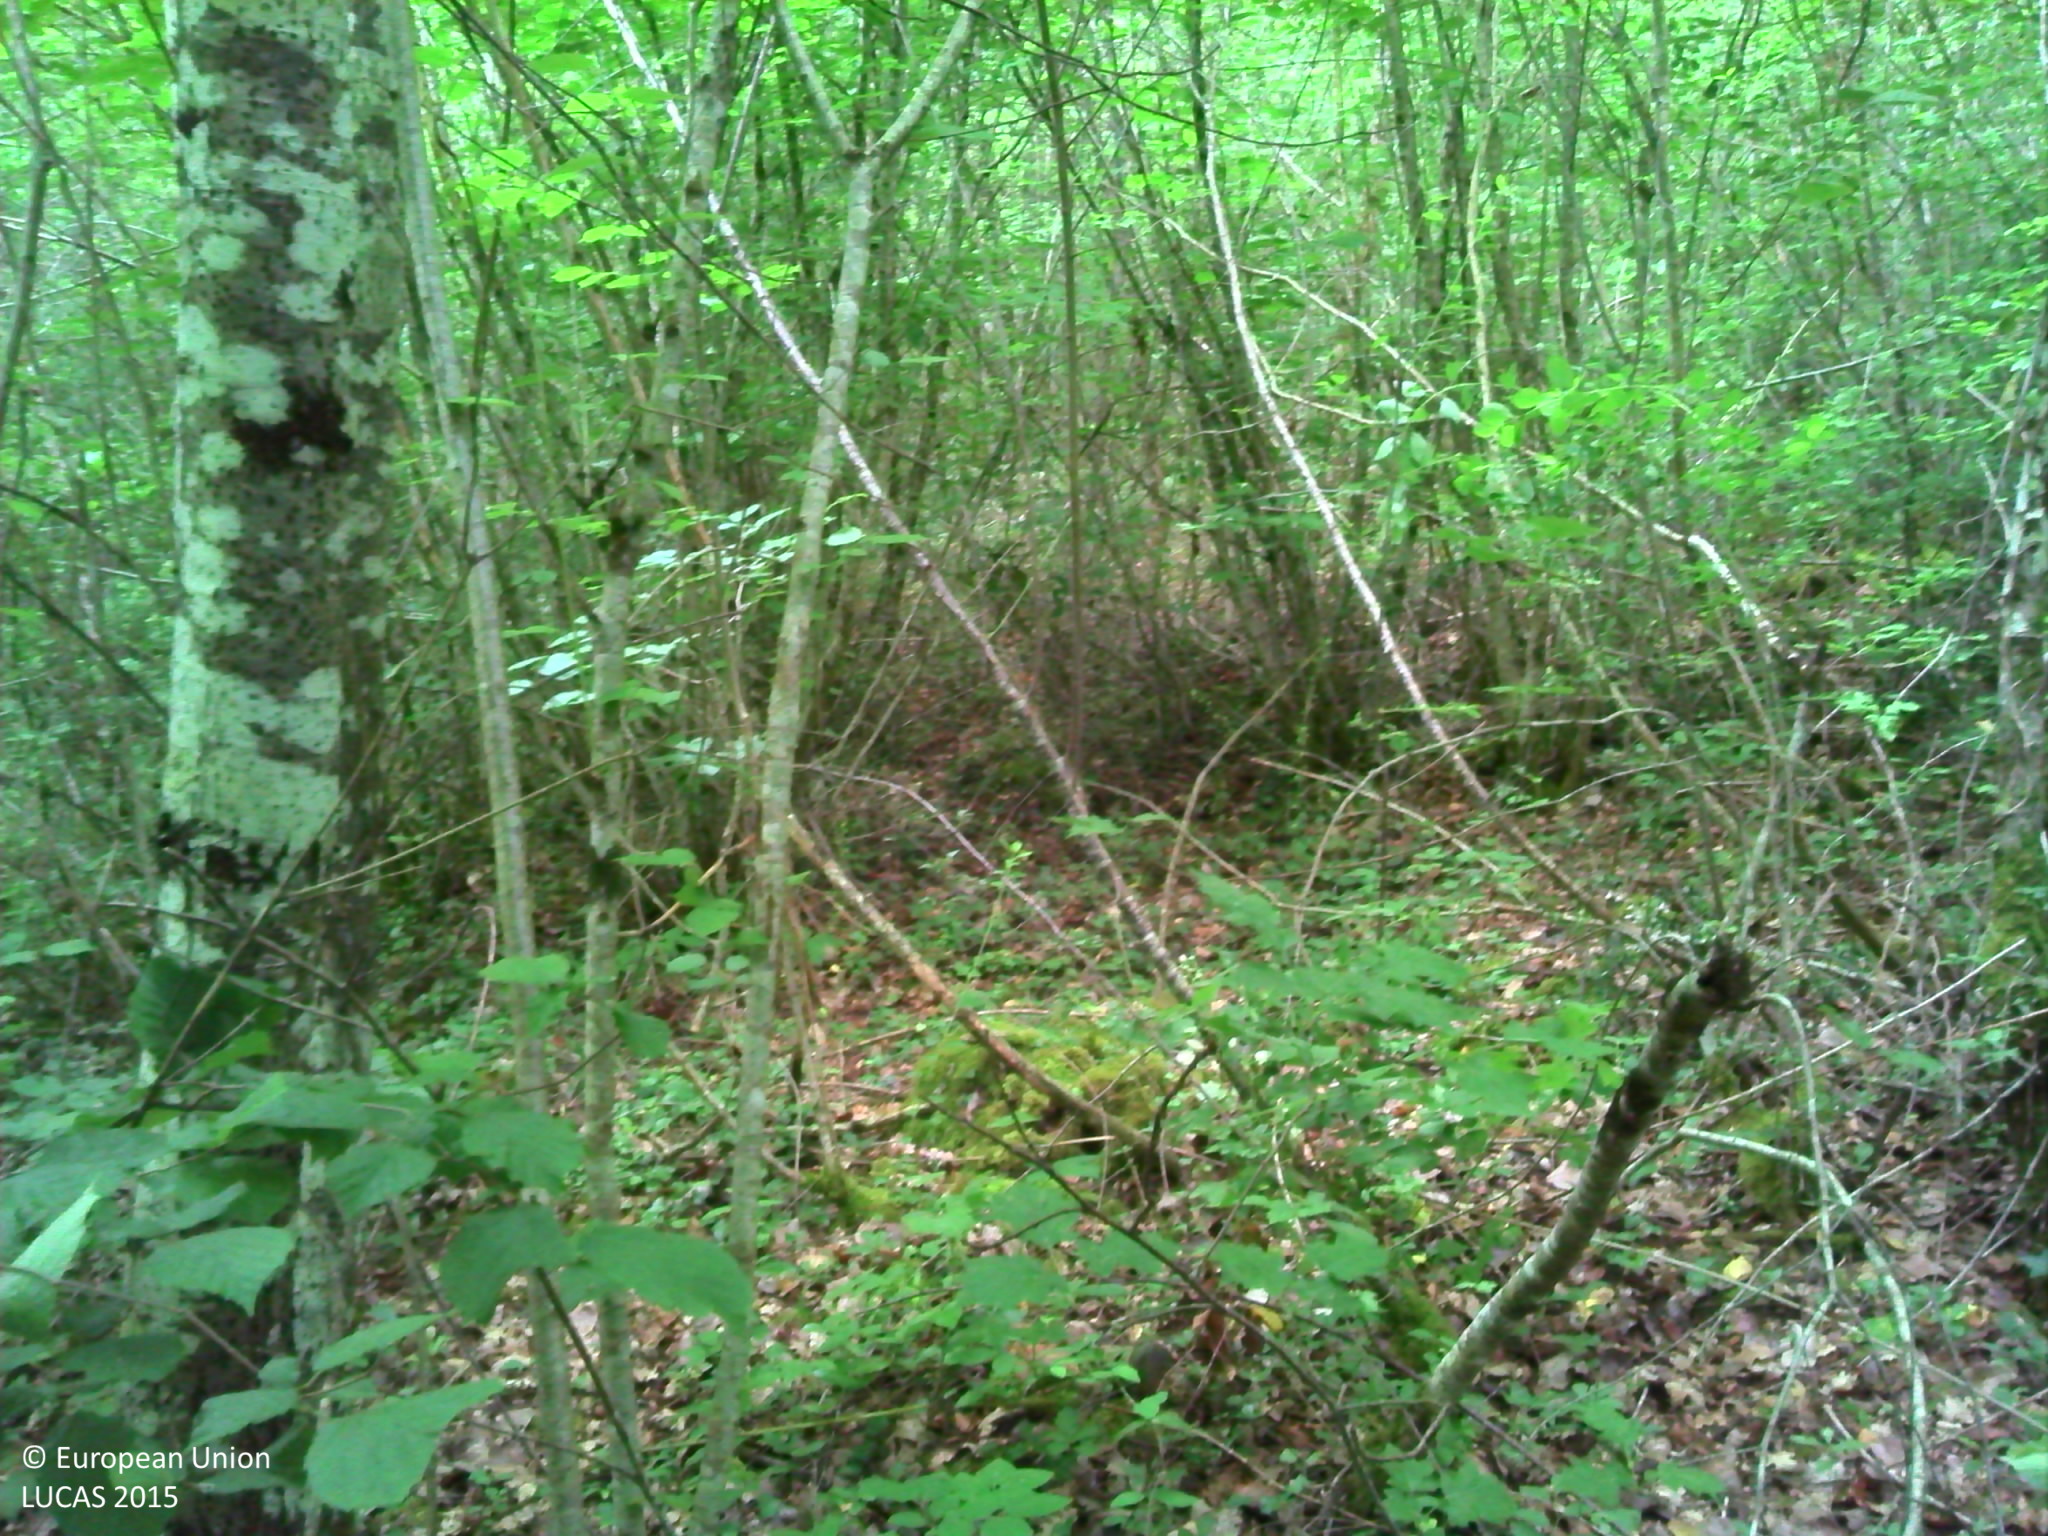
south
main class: Woodland
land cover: Broadleaved woodland
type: thermophilous deciduous forest
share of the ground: > 75 %
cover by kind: broadleaved forest trees 90 %, herbaceous plants 5 %, lichens and mosses 5 %
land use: Forestry
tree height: > 5 m
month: June
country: FR
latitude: 43.6049
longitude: 0.6945
